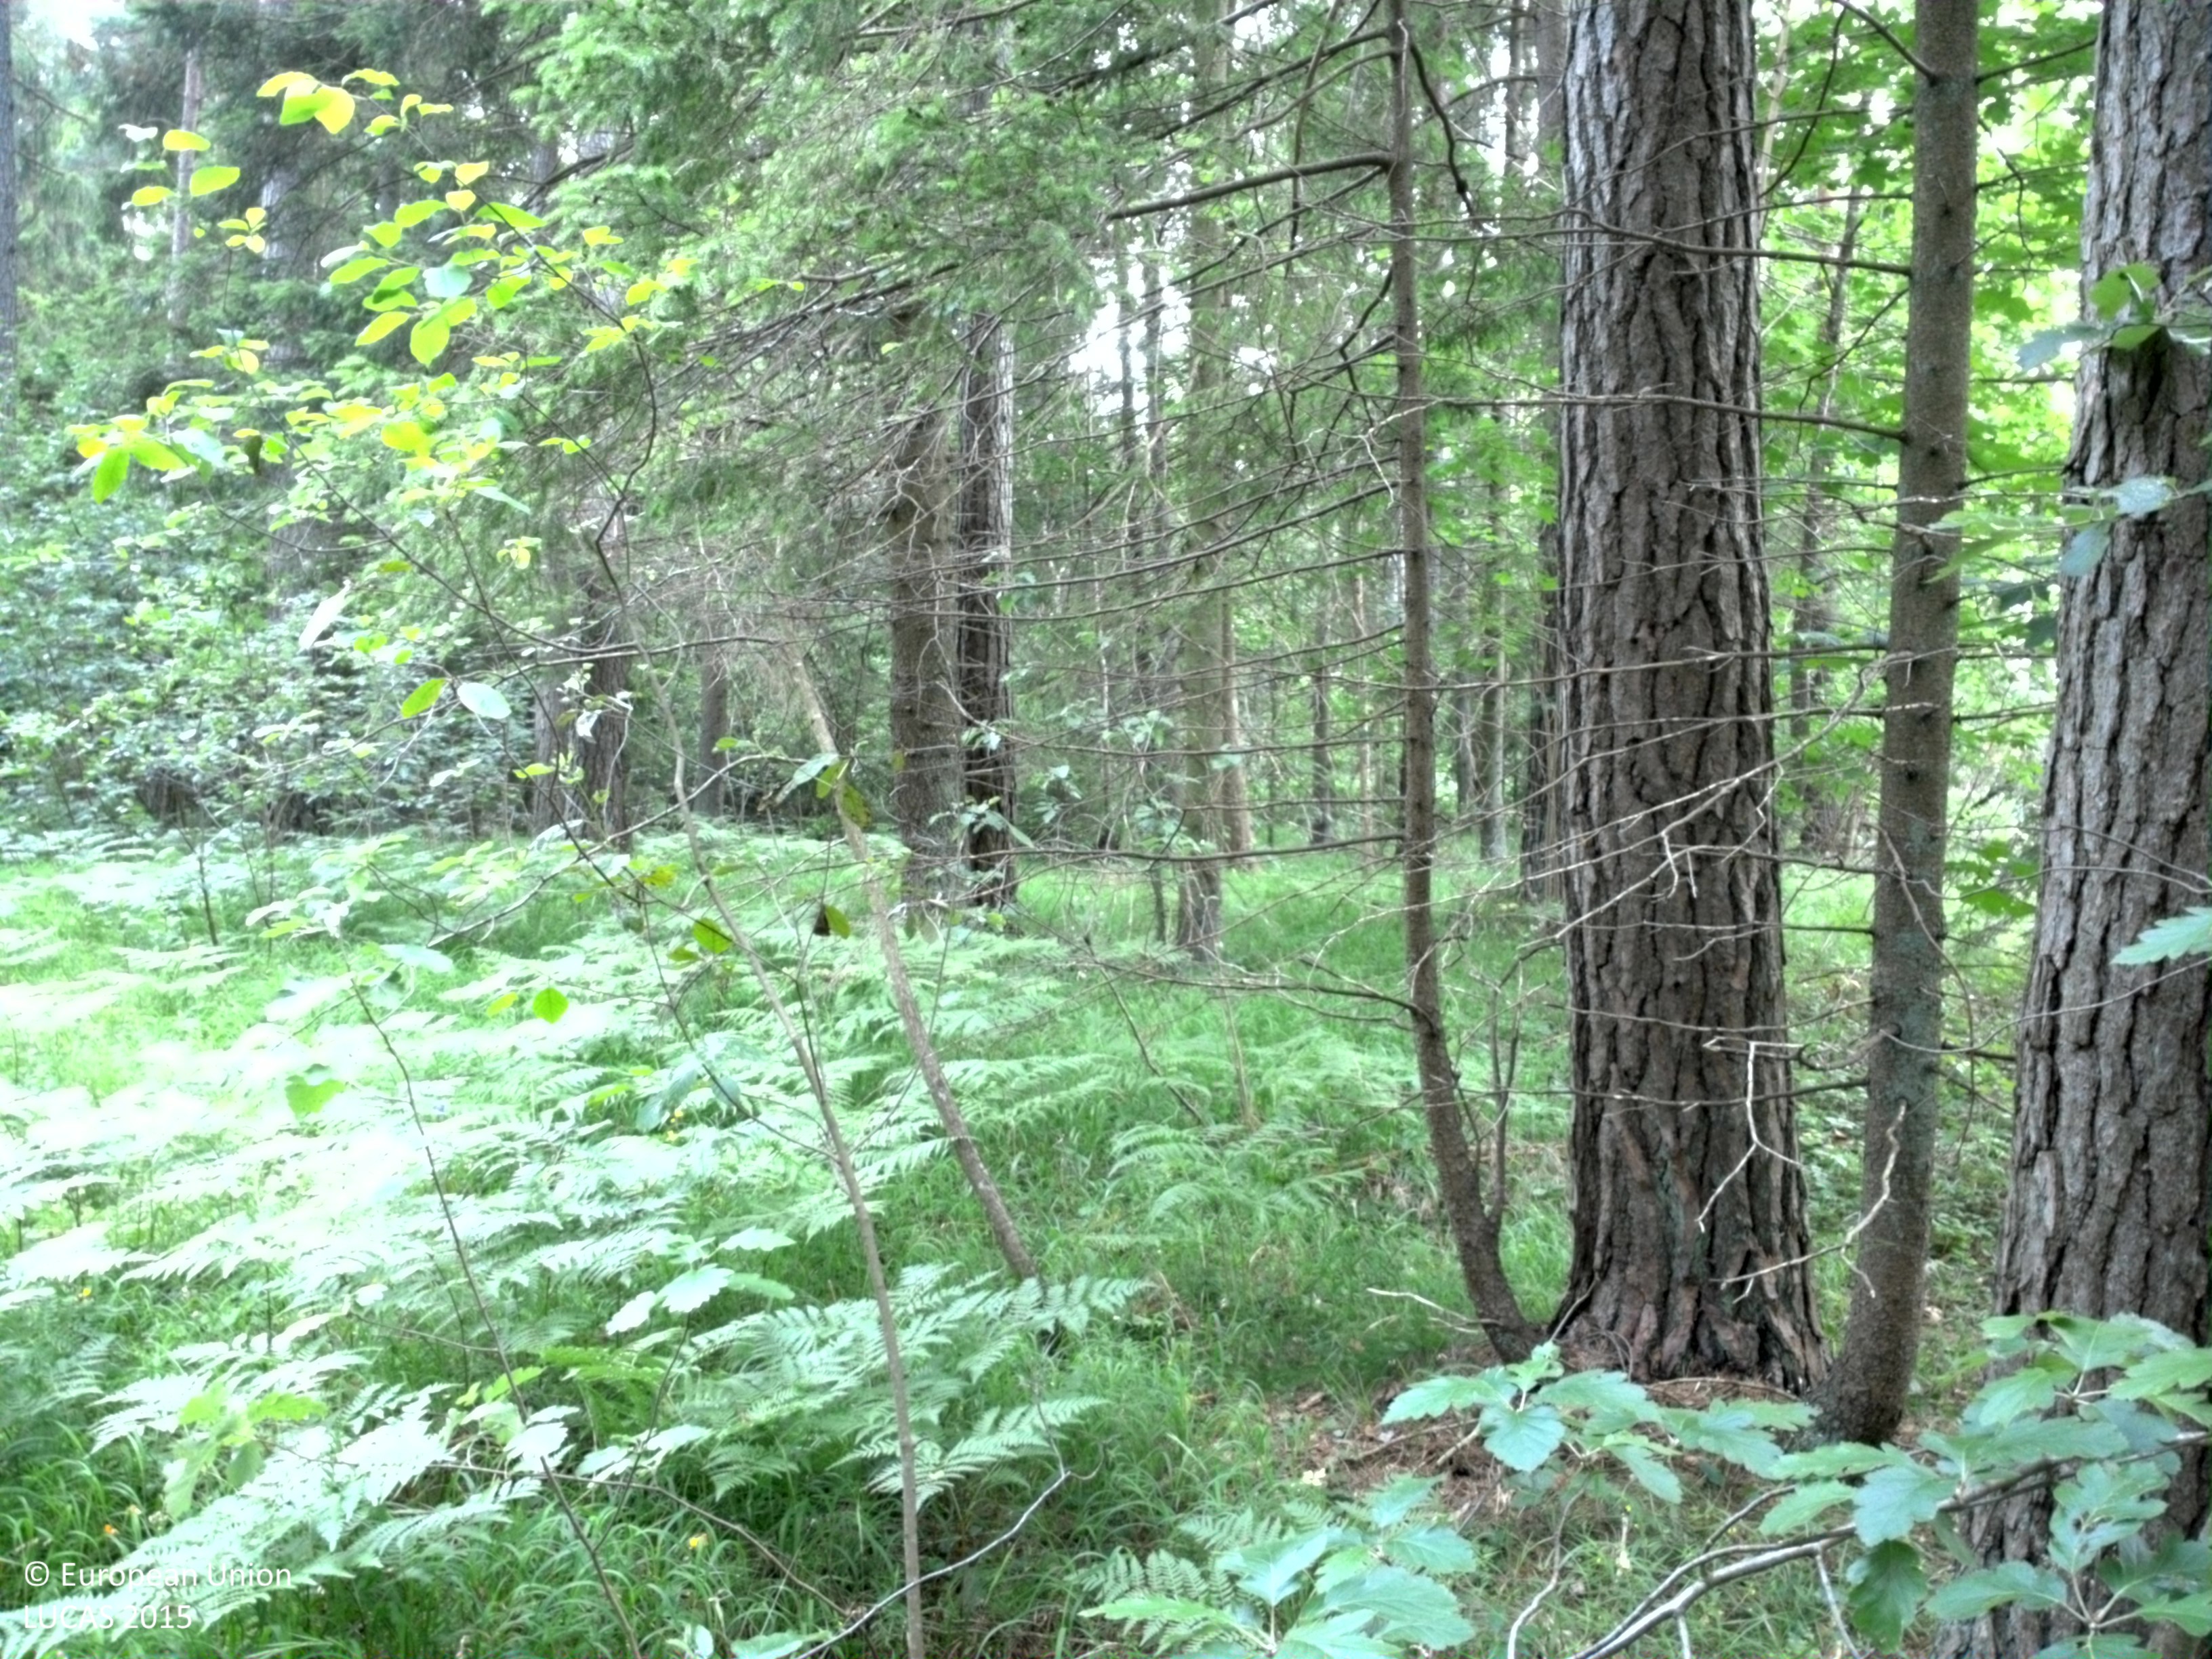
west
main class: Woodland
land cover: Spruce dominated coniferous woodland
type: hemiboreal forest and nemoral coniferous forest and mixed broadleaved-coniferous forest
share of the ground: 50 - 75 %
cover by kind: coniferous forest trees 60 %, herbaceous plants 25 %, shrubs 10 %, broadleaved forest trees 5 %
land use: Forestry
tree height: > 5 m
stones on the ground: < 10 %
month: July
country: SE
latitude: 57.4796
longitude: 18.4978
